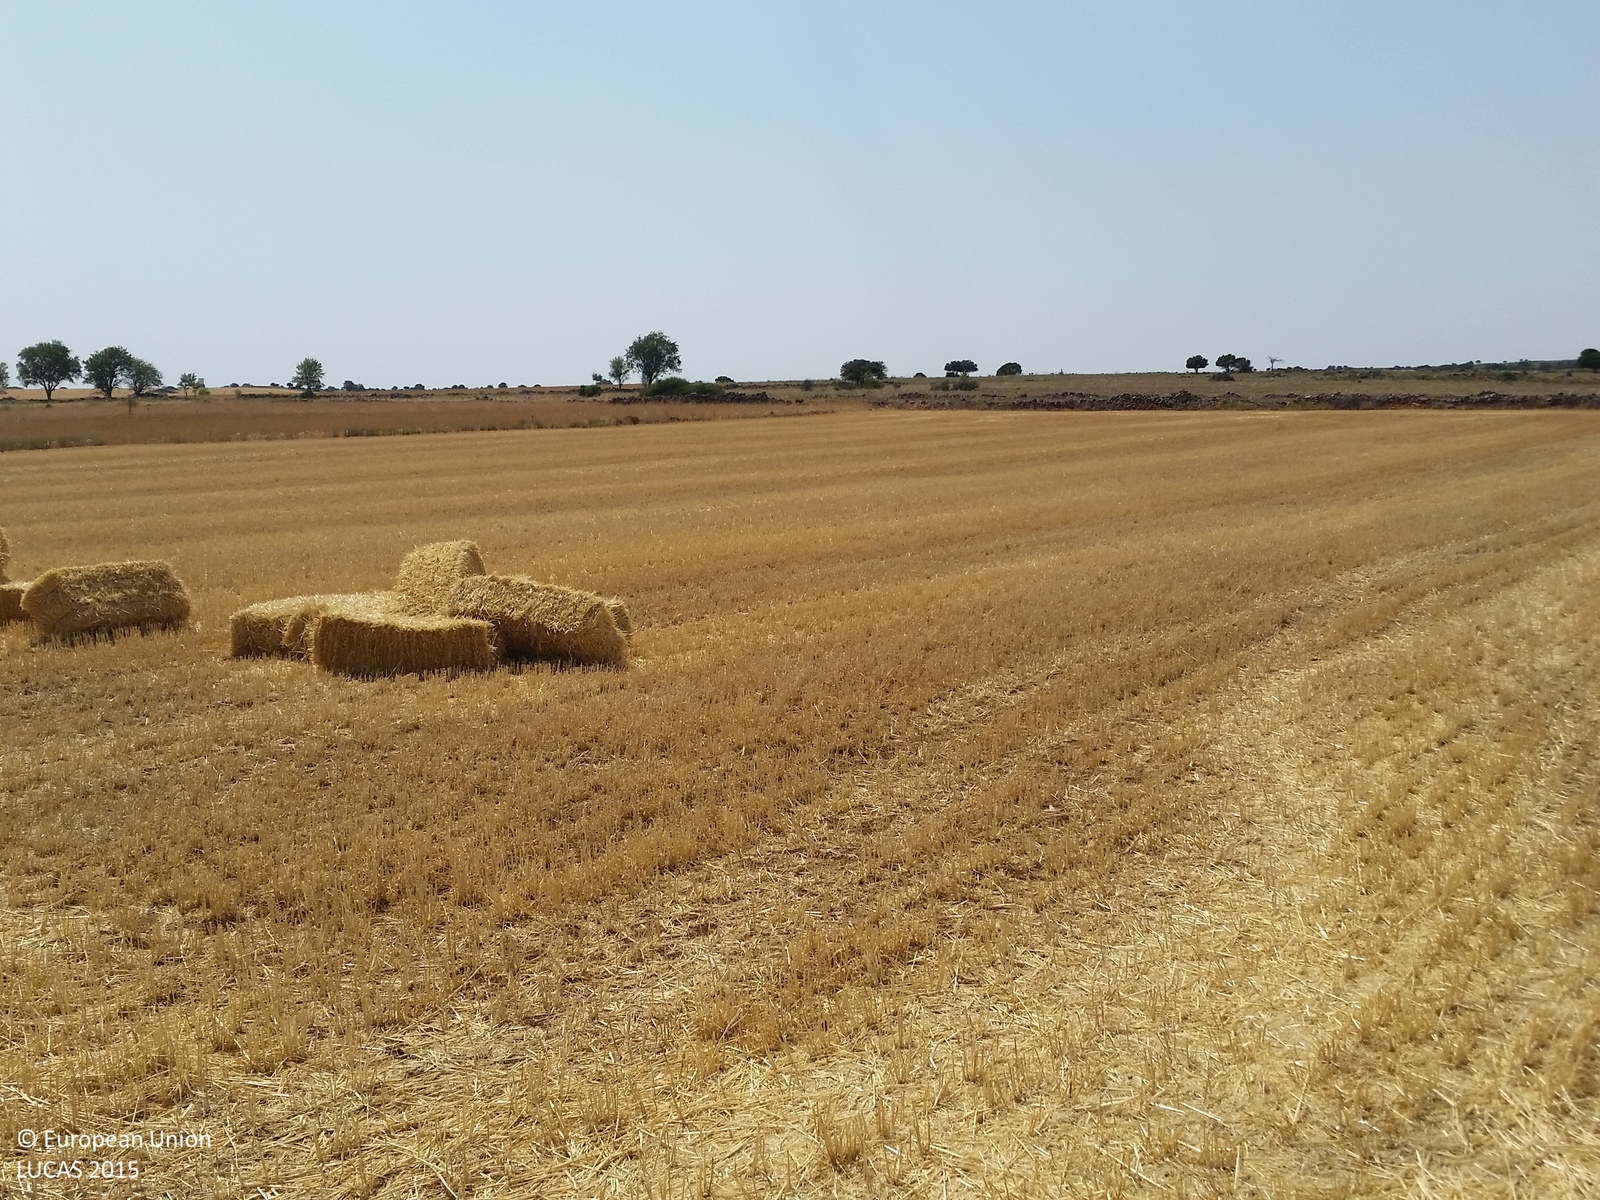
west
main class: Cropland
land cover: Barley
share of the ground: < 10 %
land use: Agriculture (excluding fallow land and kitchen gardens)
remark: Harvested field
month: June
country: ES
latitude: 38.8628
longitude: -2.4847
